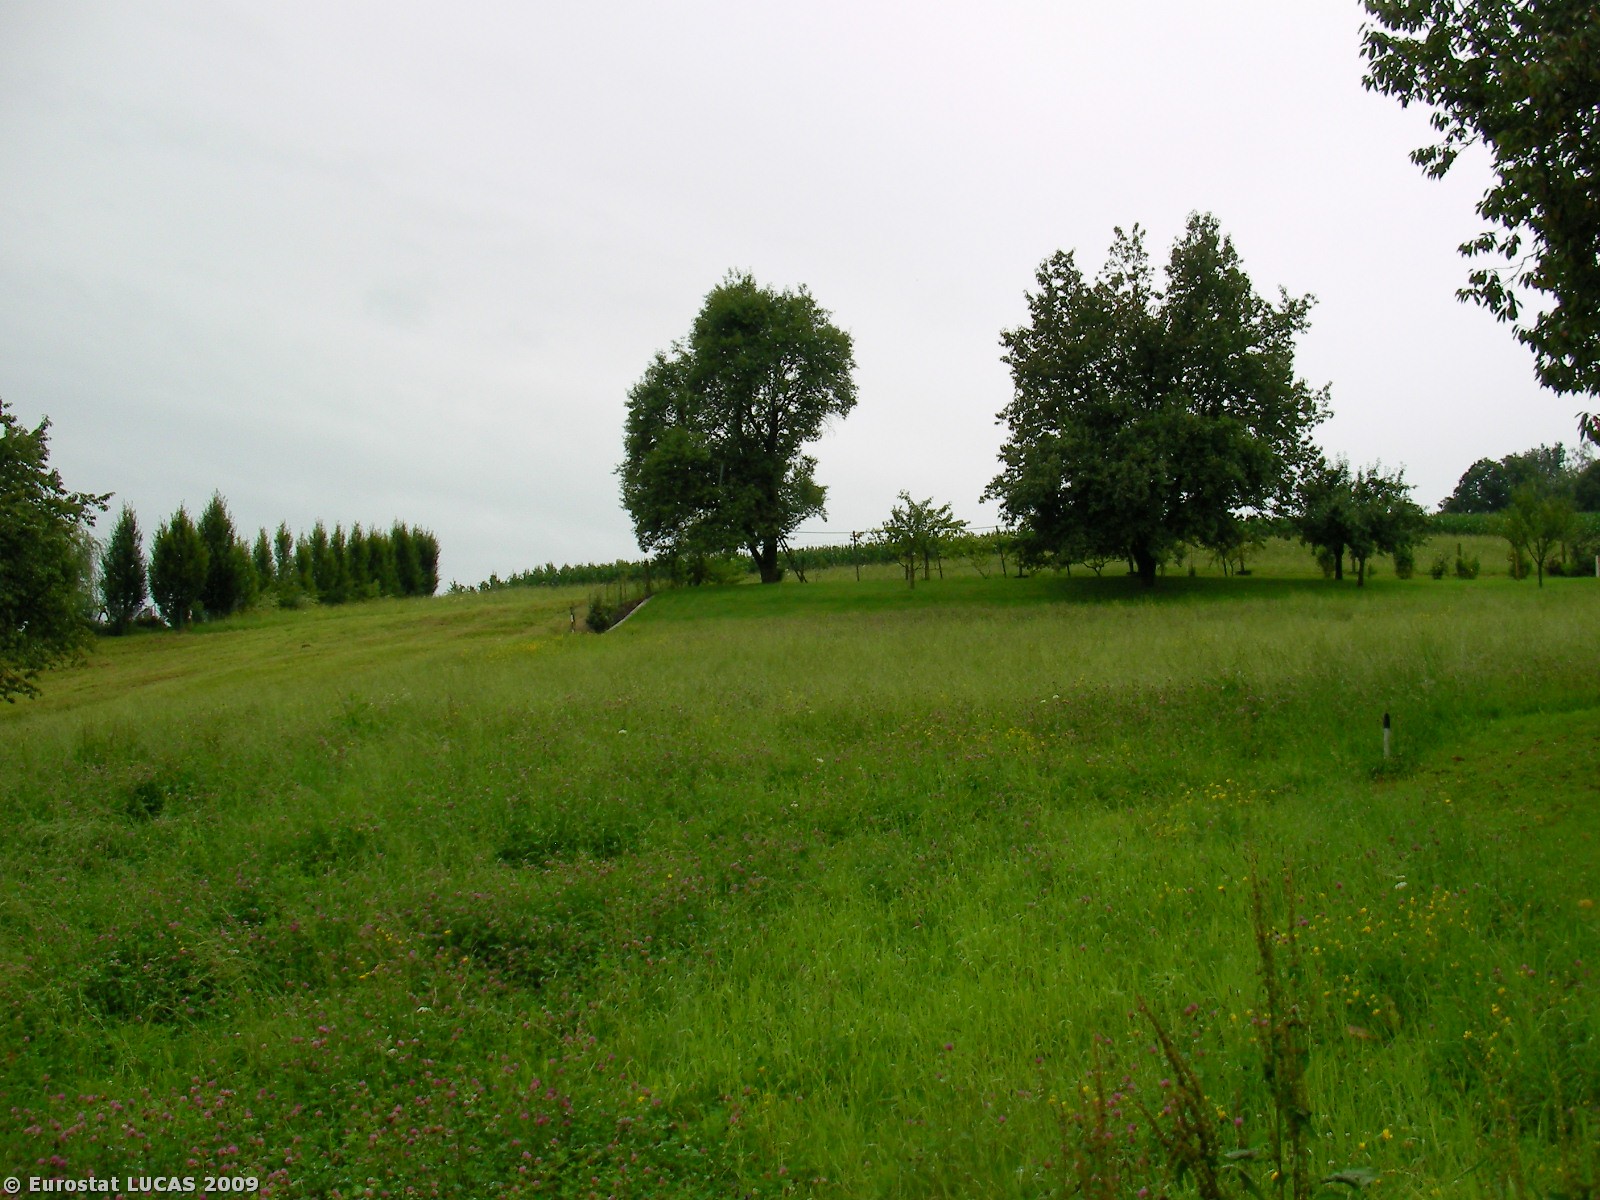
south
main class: Grassland
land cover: Grassland without tree/shrub cover
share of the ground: > 75 %
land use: Agriculture (excluding fallow land and kitchen gardens)
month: July
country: AT
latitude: 46.9027
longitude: 15.7105
